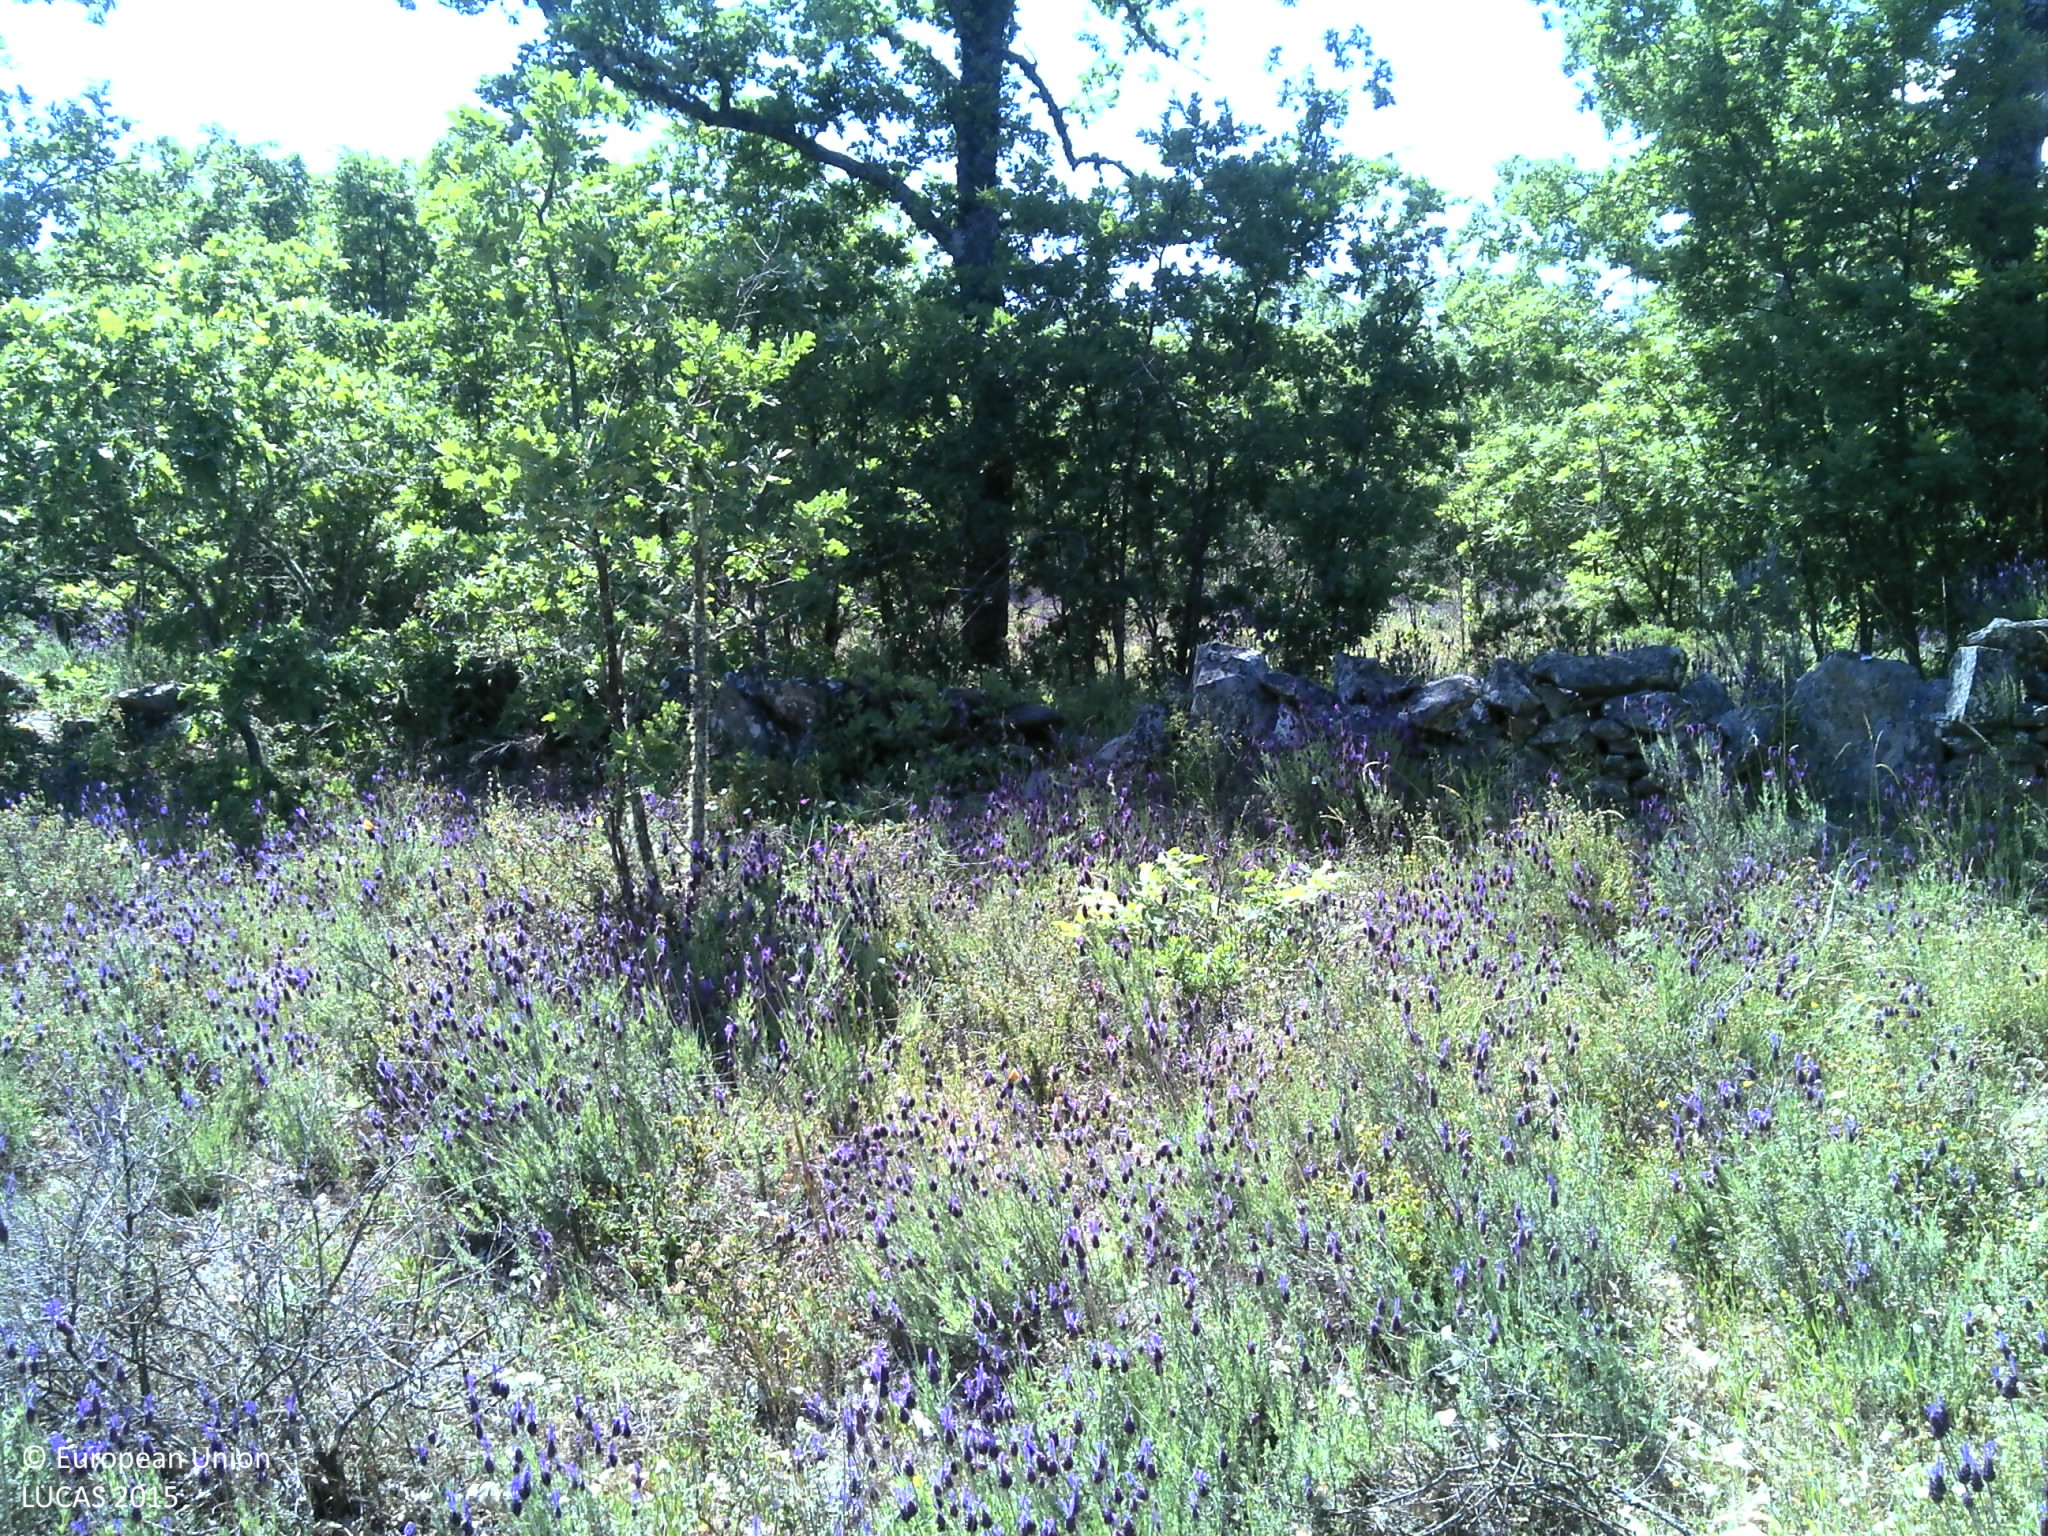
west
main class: Shrubland
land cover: Shrubland with sparse tree cover
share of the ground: > 75 %
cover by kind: shrubs 80 %, herbaceous plants 10 %, broadleaved forest trees 5 %, unconsolidated bare surface 5 %
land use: Forestry
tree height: > 5 m
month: May
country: PT
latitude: 41.5860
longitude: -6.3789
